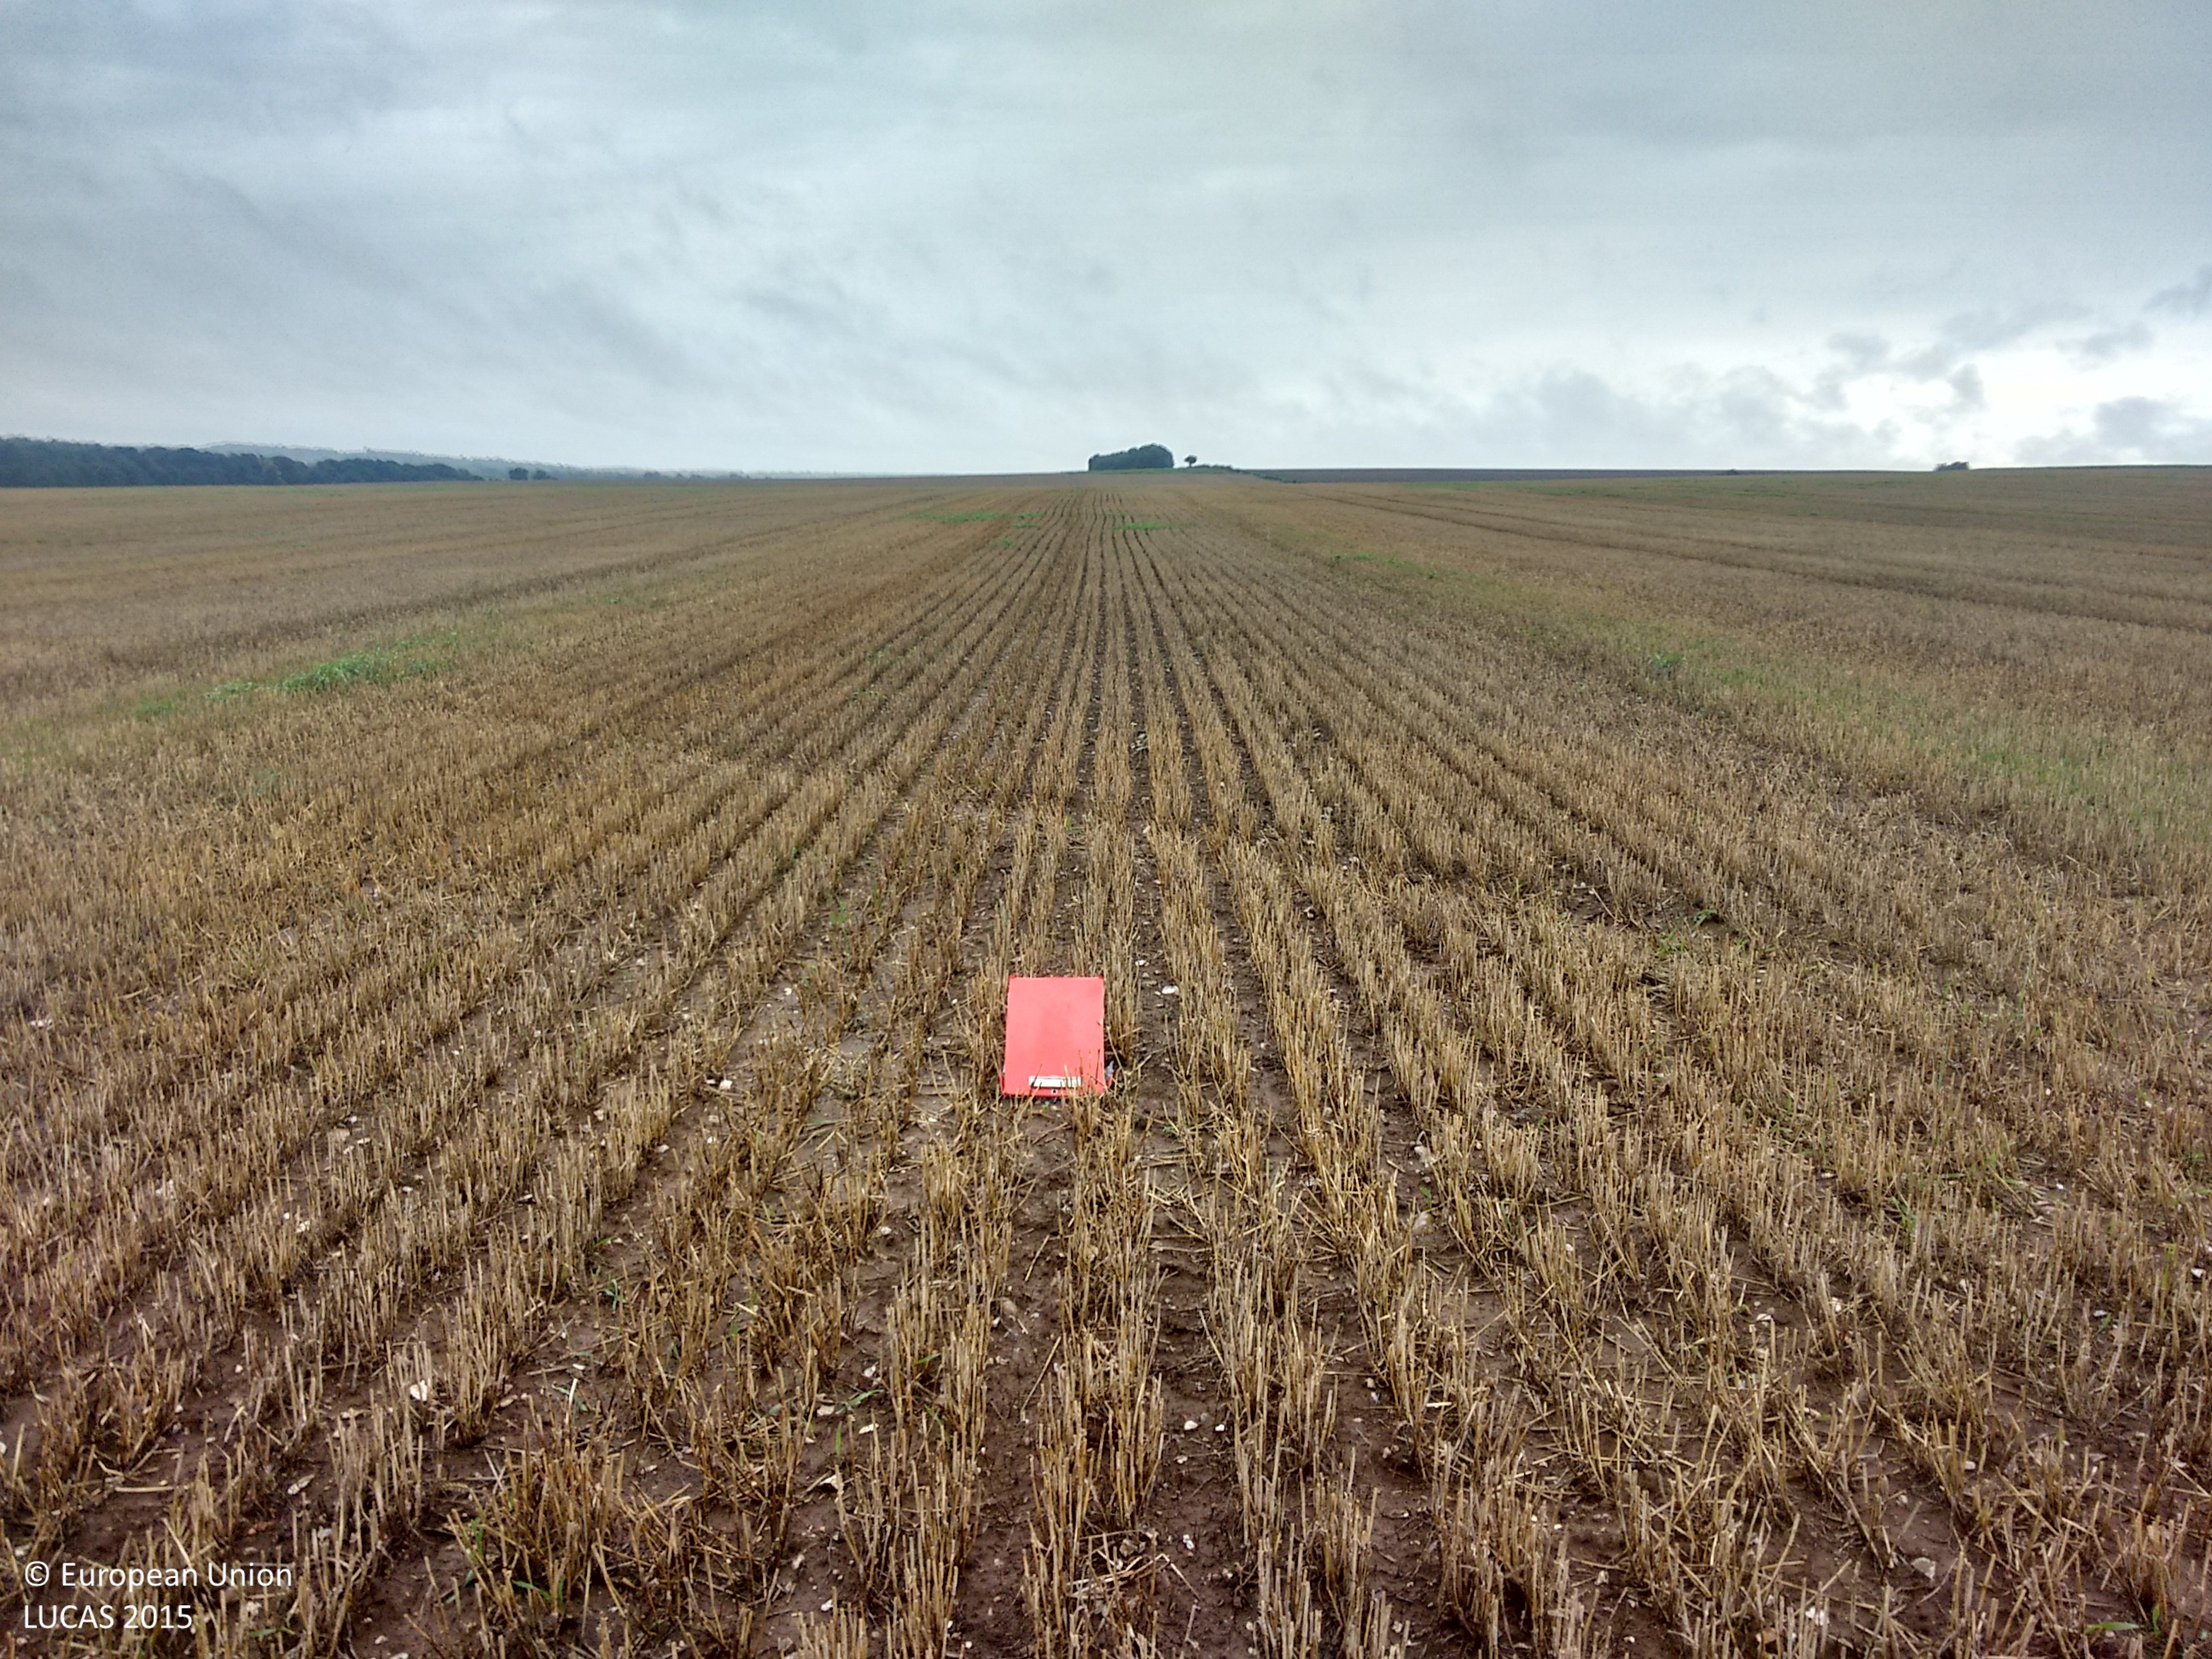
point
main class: Cropland
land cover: Barley
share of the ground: 50 - 75 %
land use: Agriculture (excluding fallow land and kitchen gardens)
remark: Harvested field
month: August
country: GB
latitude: 52.1077
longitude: 0.3193
